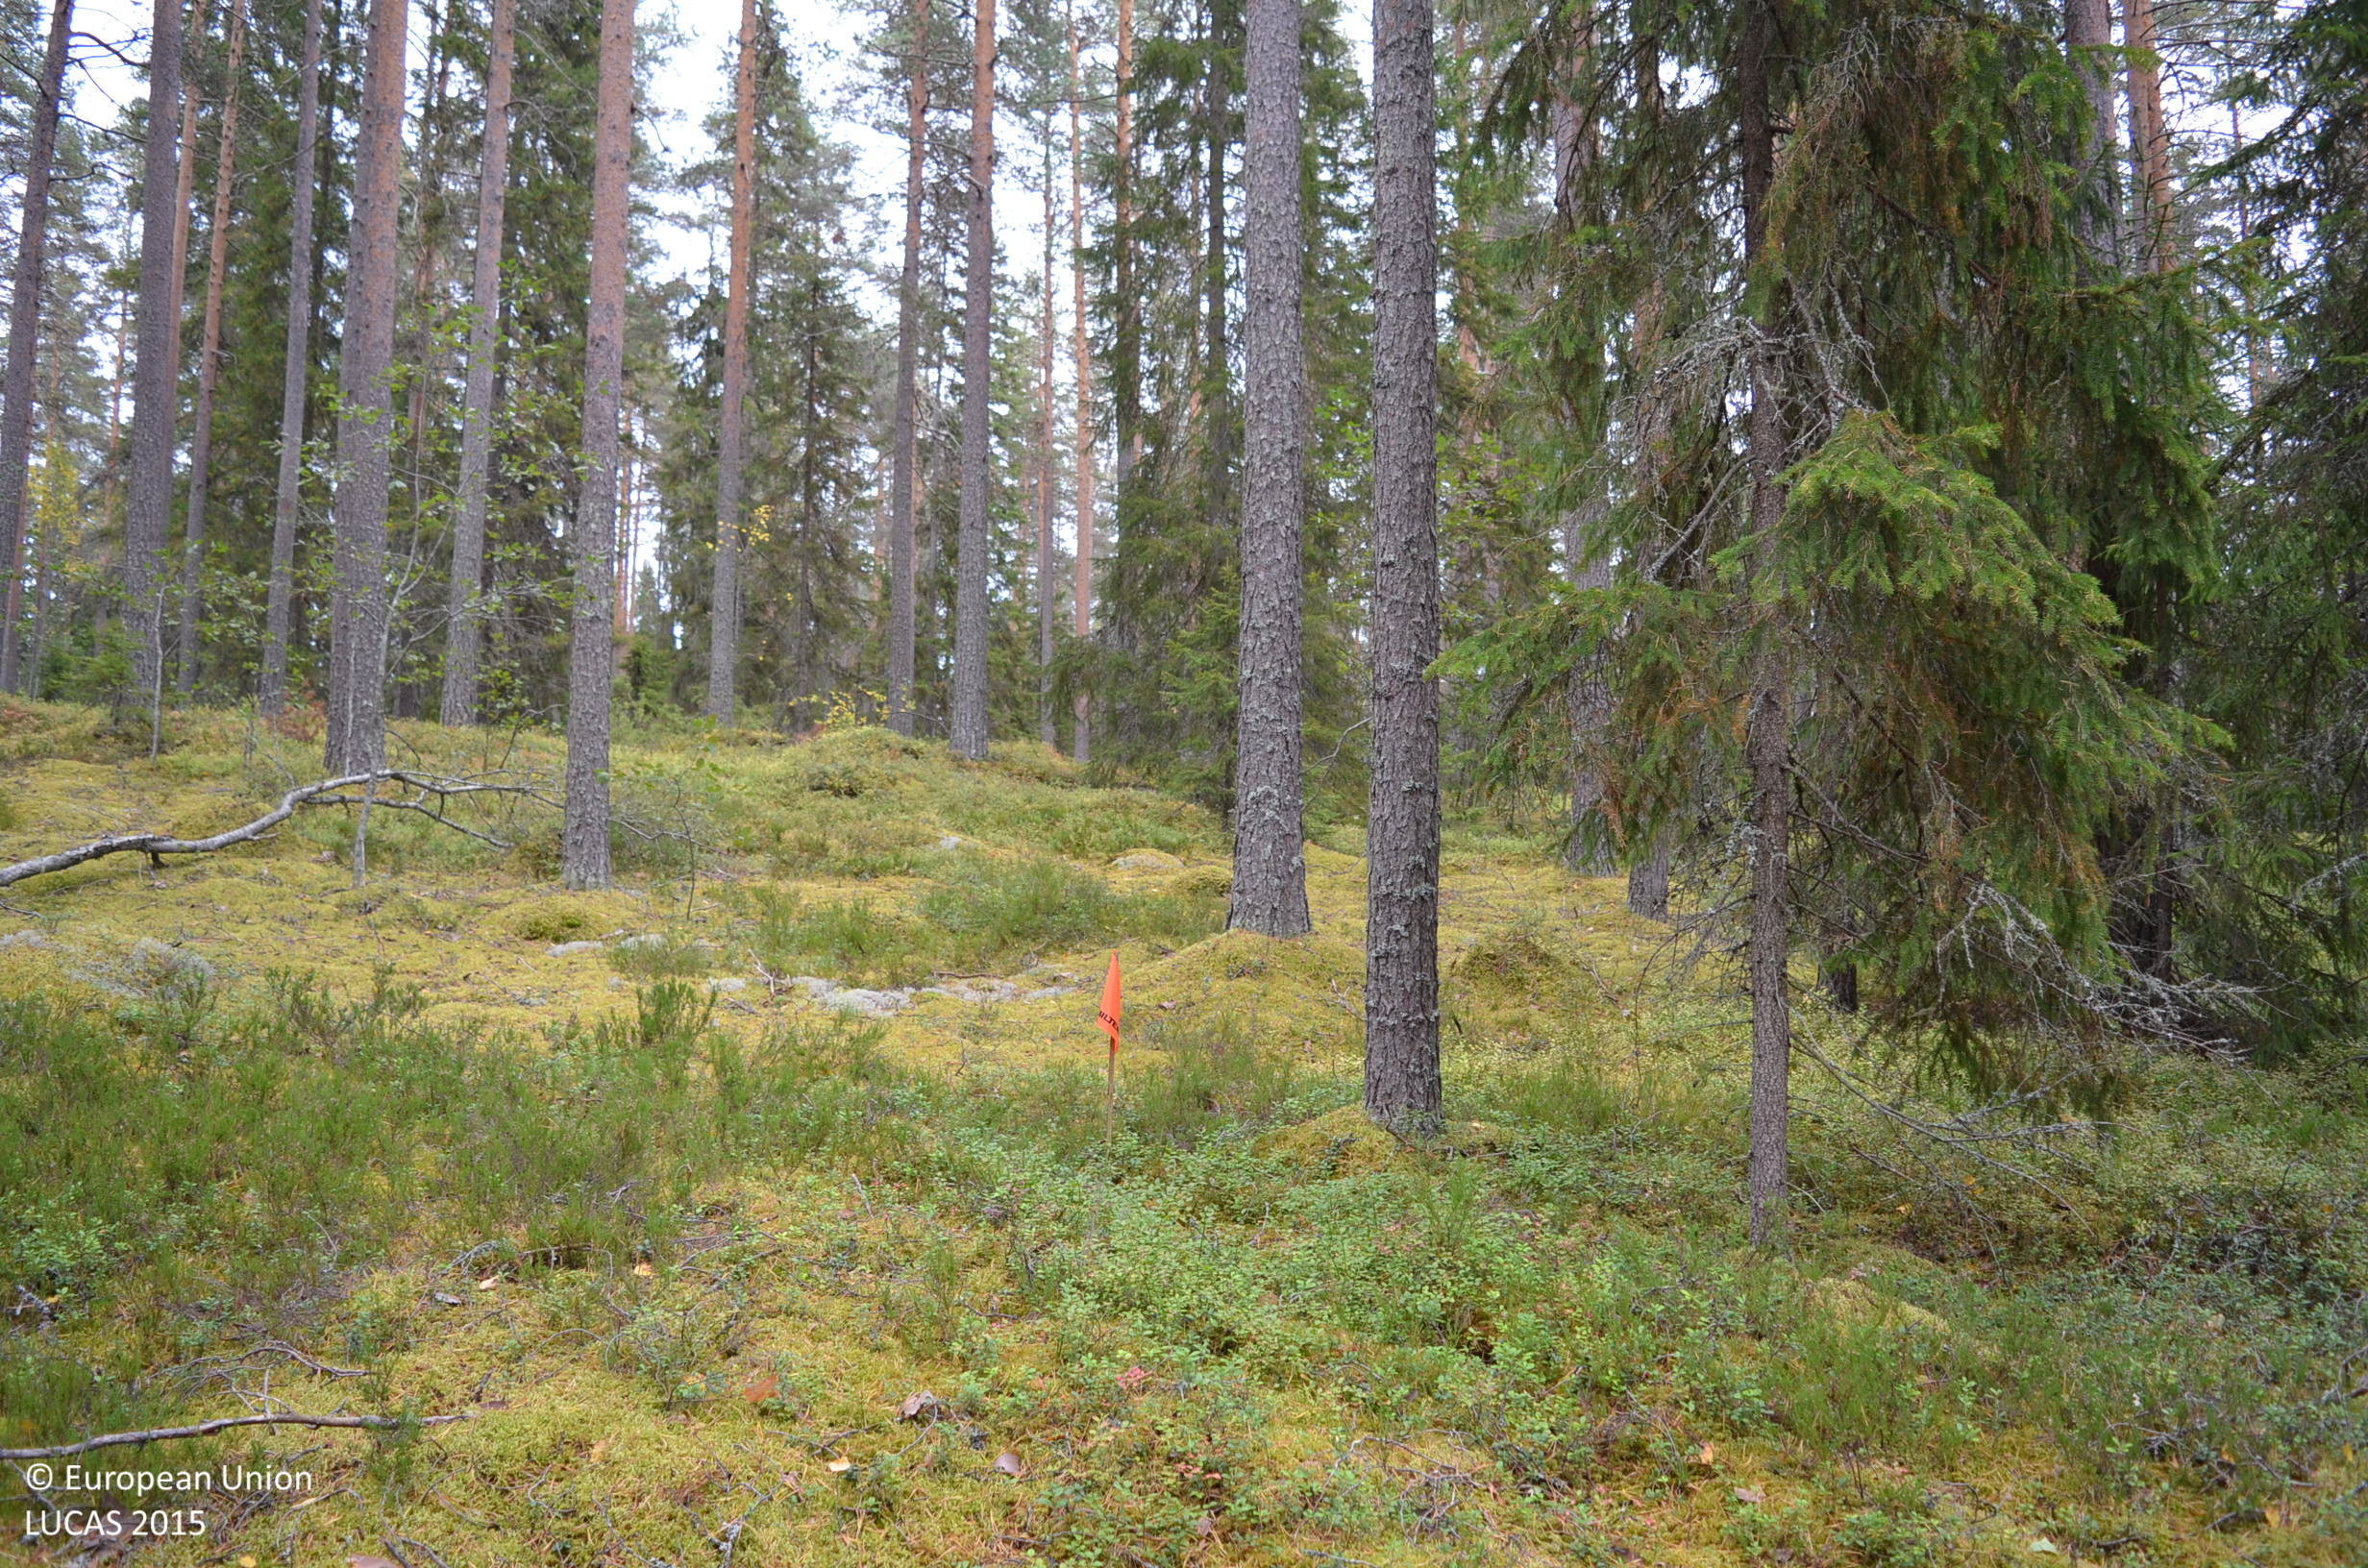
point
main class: Woodland
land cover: Other coniferous woodland
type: boreal forest
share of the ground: 50 - 75 %
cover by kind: coniferous forest trees 70 %, shrubs 15 %, lichens and mosses 15 %
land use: Forestry
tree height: > 5 m
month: September
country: FI
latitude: 62.8537
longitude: 23.8054
